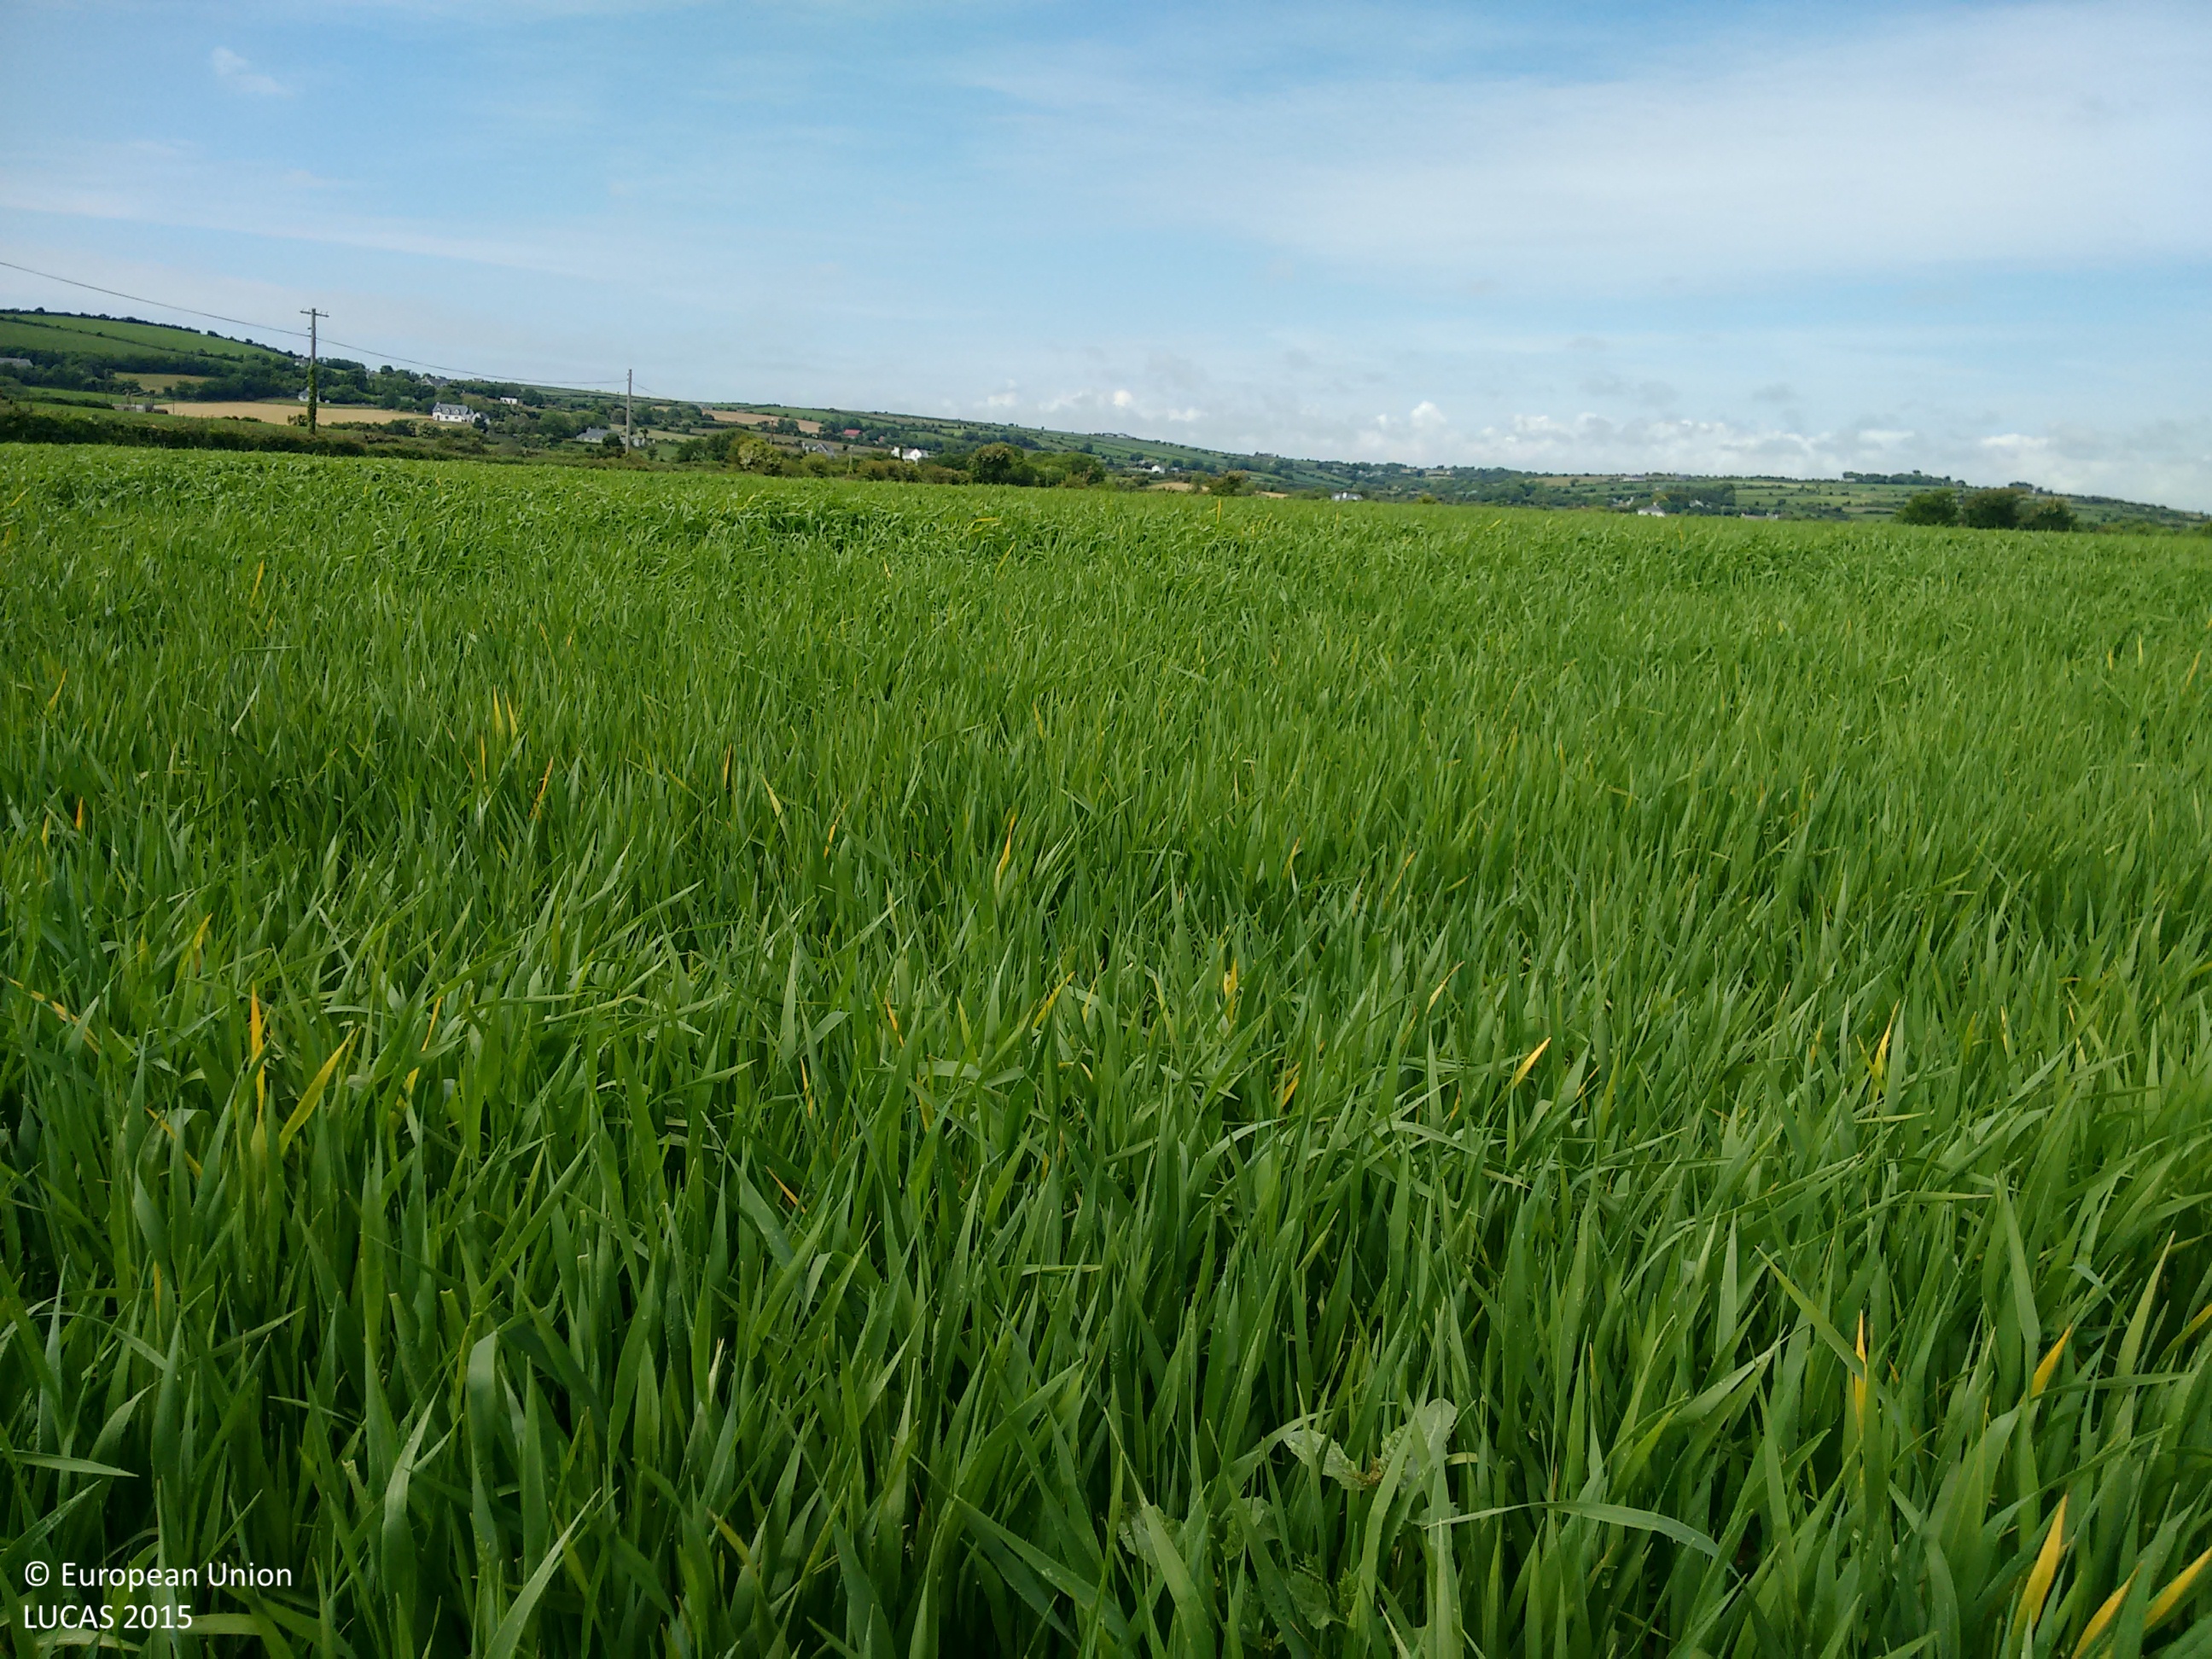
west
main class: Cropland
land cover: Barley
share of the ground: > 75 %
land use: Agriculture (excluding fallow land and kitchen gardens)
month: June
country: IE
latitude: 51.8444
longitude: -8.0462
